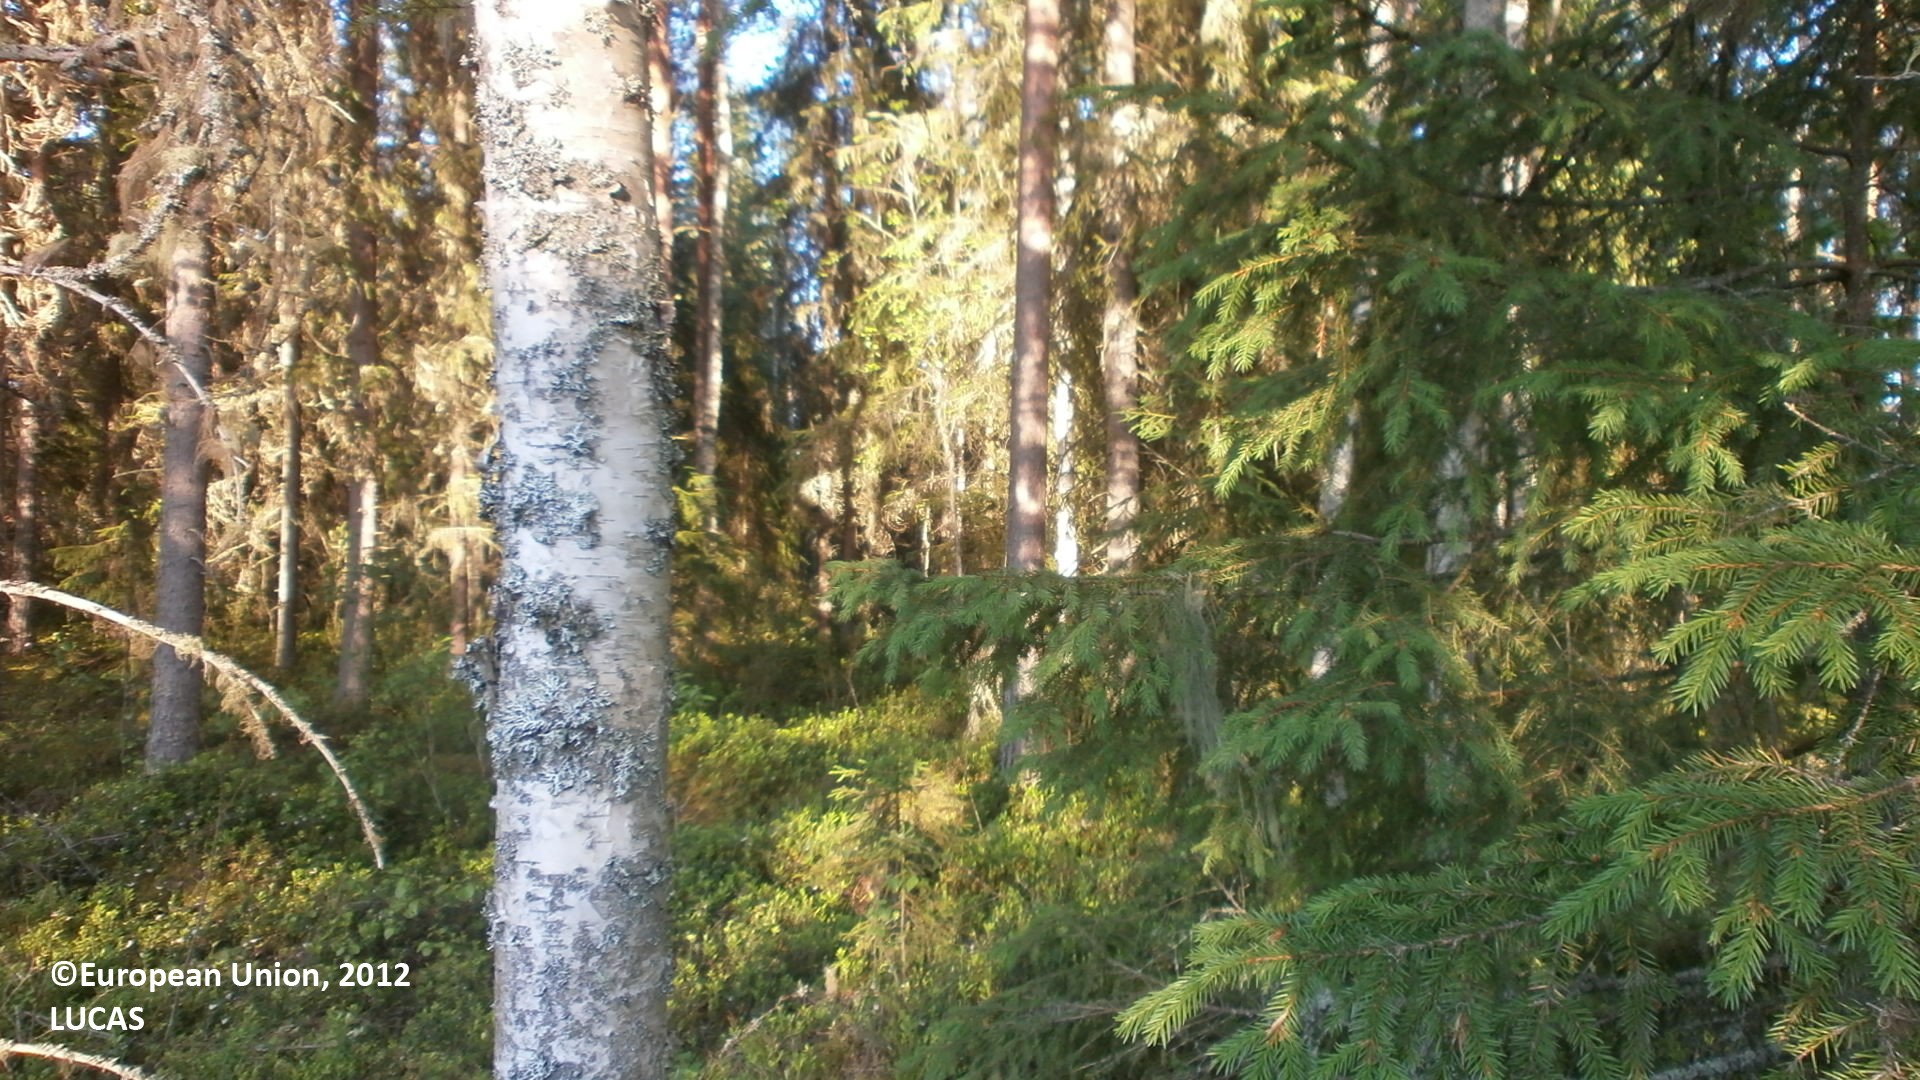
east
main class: Woodland
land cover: Spruce dominated mixed woodland
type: boreal forest
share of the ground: > 75 %
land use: Forestry
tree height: > 5 m
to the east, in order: Spruce dominated mixed woodland; Ditches and canals; Spruce dominated coniferous woodland; Pine dominated mixed woodland; Ditches and canals; Pine dominated coniferous woodland; Ditches and canals; Pine dominated mixed woodland; Shrubland with sparse tree cover; Pine dominated mixed woodland; Ditches and canals; Shruby margins; Paved roads, cycling and walking lanes; Shruby margins
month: July
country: FI
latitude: 64.0097
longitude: 24.8276
